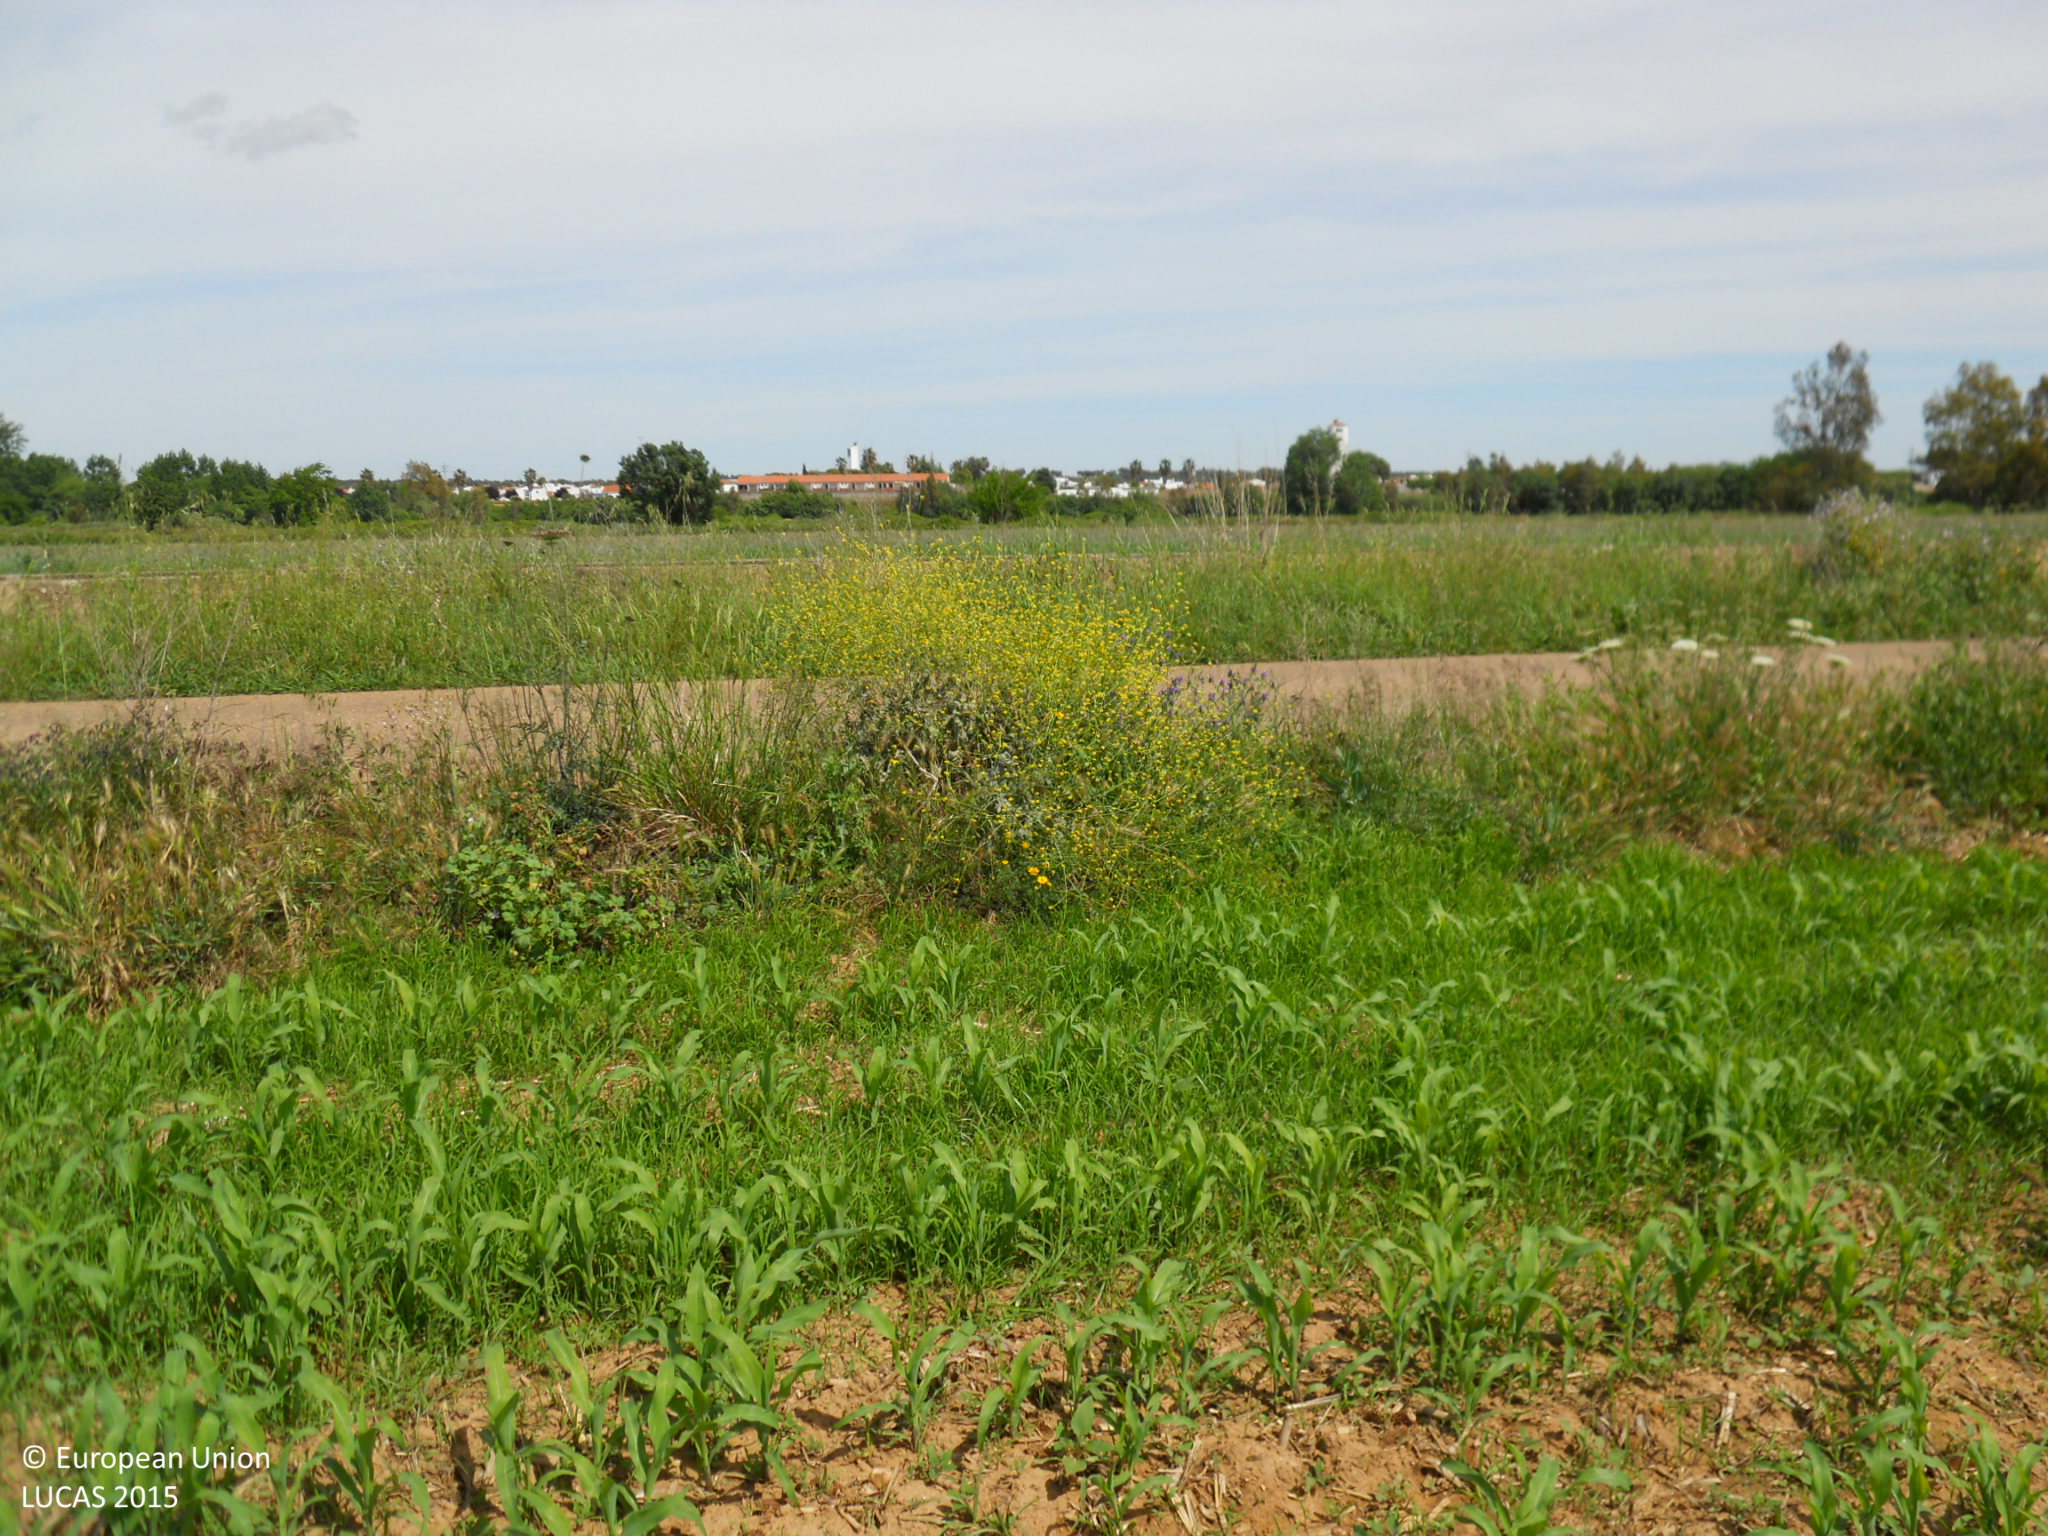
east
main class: Cropland
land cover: Maize
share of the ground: 10 - 25 %
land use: Agriculture (excluding fallow land and kitchen gardens)
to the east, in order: Maize; Paved roads, cycling and walking lanes; Ditches and canals; Rye; Barley; Maize; Shruby margins; Rivers and streams; Tomatoes
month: April
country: ES
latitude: 38.9678
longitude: -6.9327
